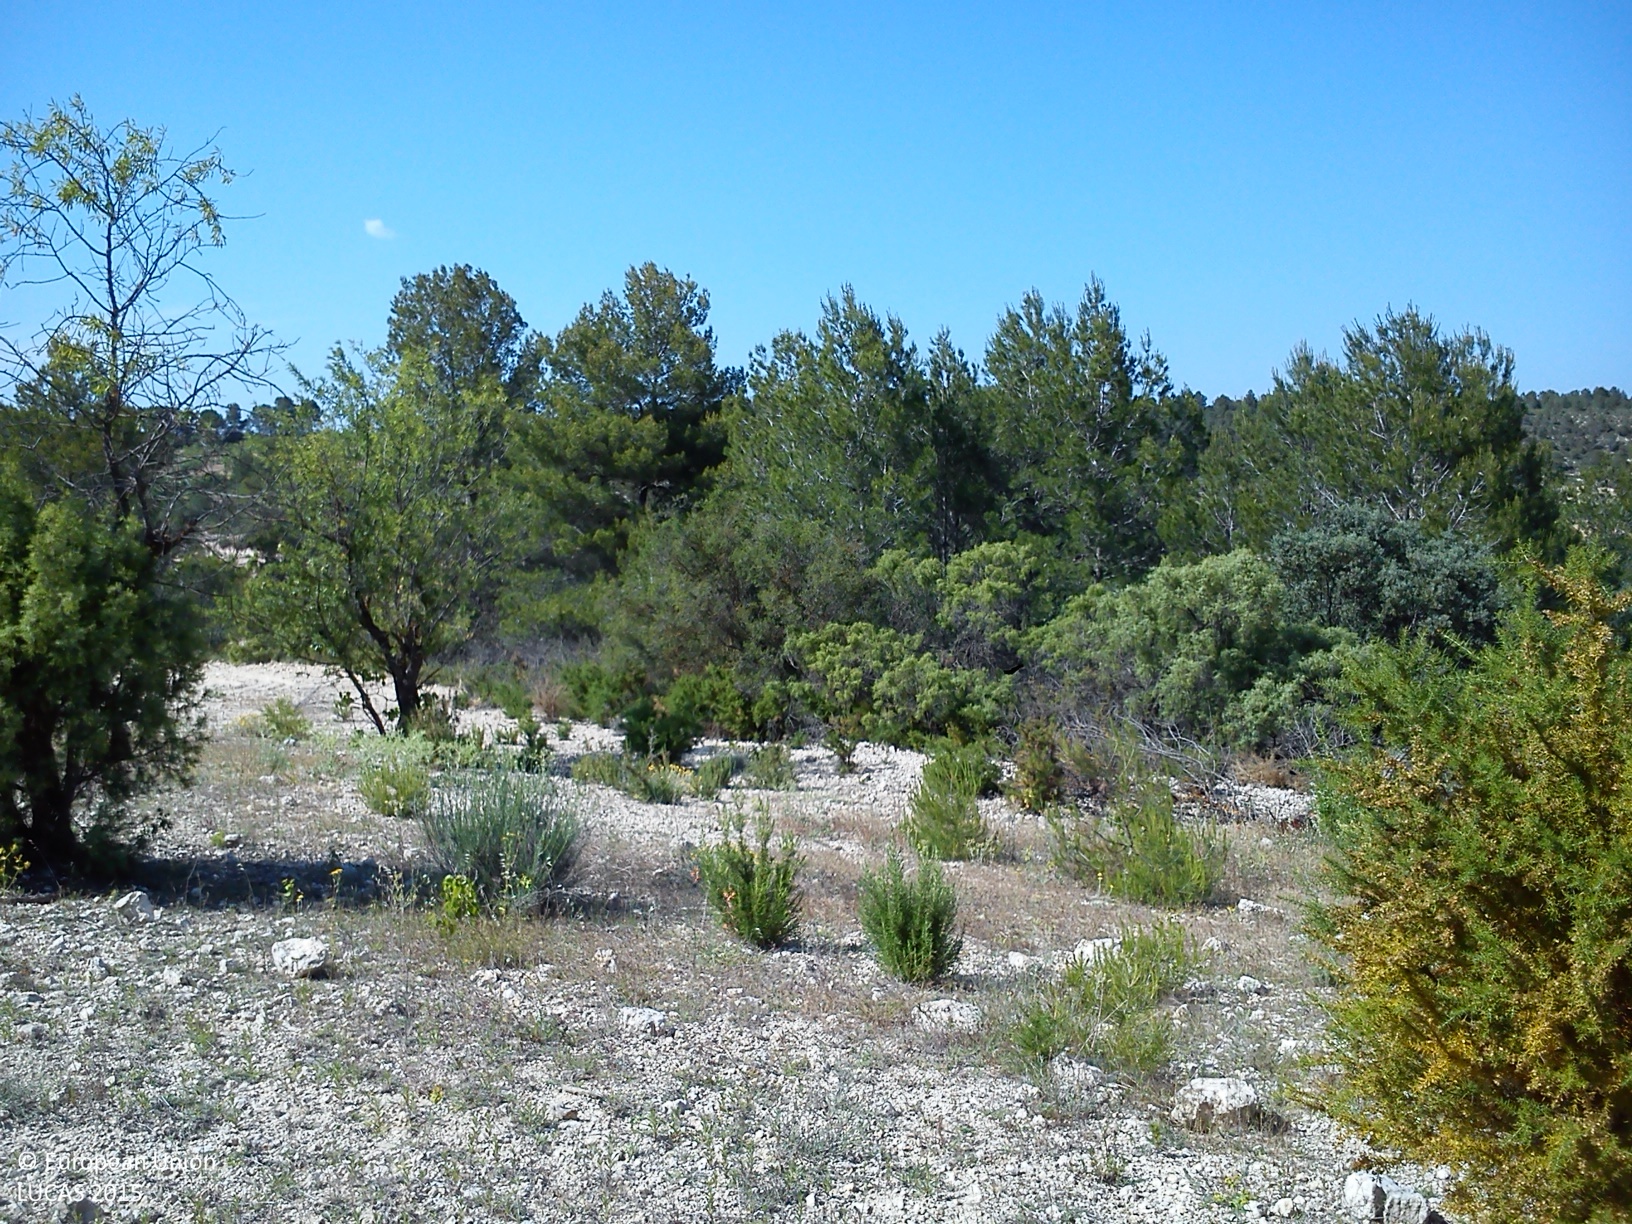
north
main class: Shrubland
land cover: Shrubland with sparse tree cover
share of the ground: 10 - 25 %
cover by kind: herbaceous plants 40 %, unconsolidated bare surface 35 %, shrubs 20 %, coniferous forest trees 5 %
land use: Abandoned areas
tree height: < 5 m
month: June
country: ES
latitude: 39.3098
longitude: -1.0746
